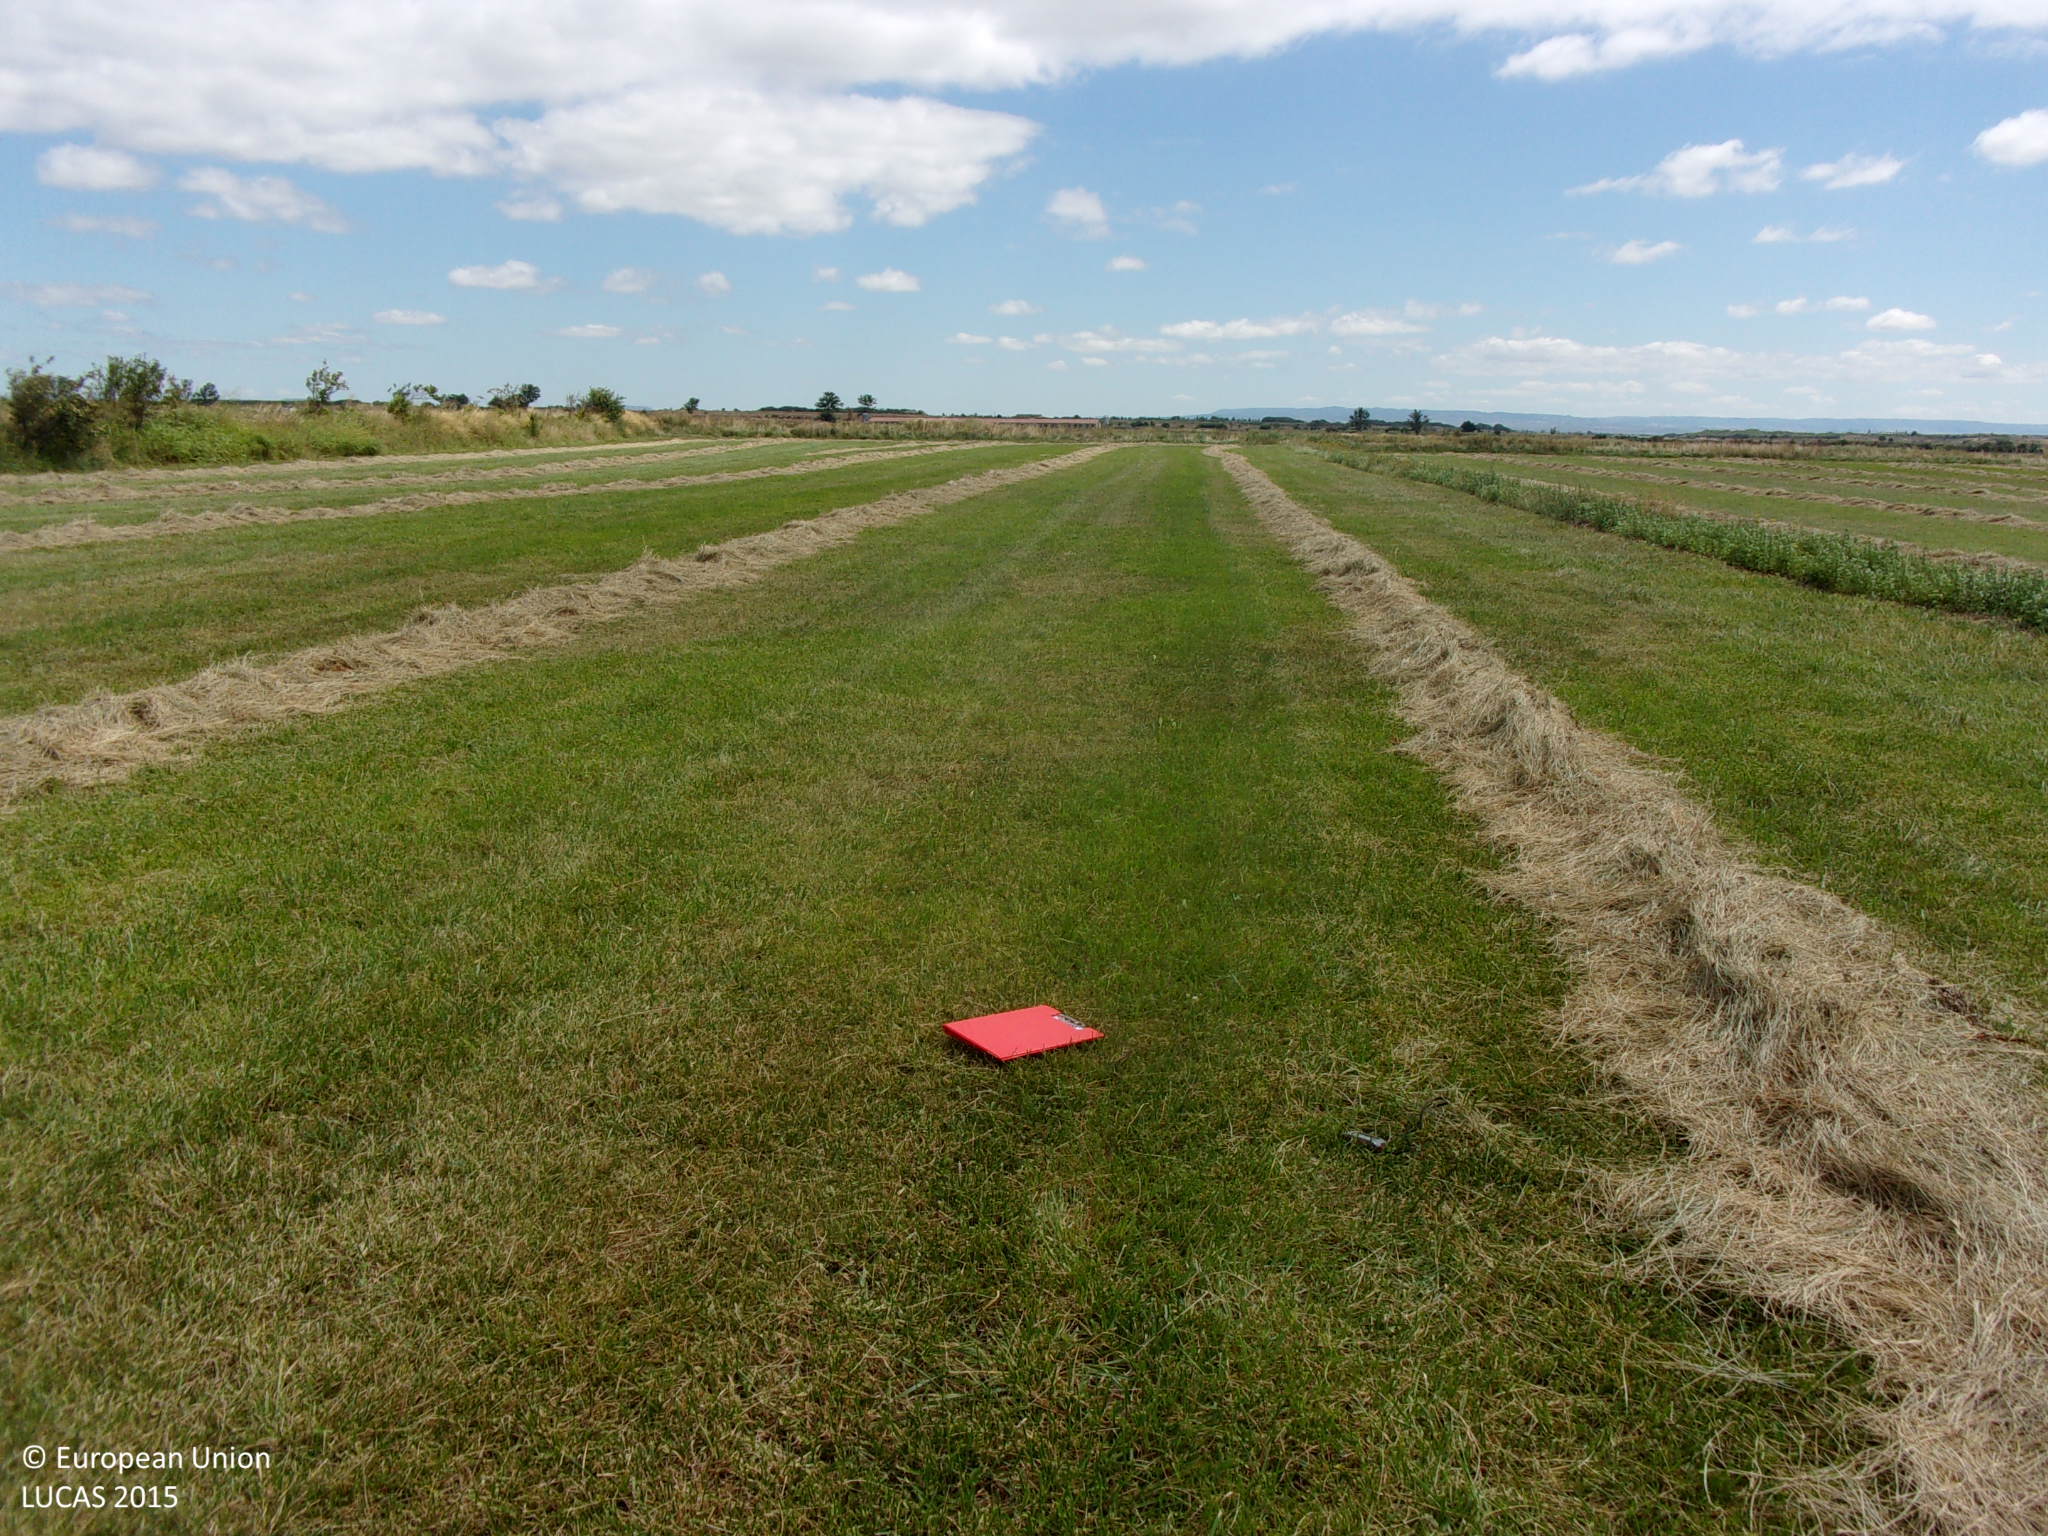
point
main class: Cropland
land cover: Mixed cereals for fodder
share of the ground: > 75 %
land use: Agriculture (excluding fallow land and kitchen gardens)
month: August
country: ES
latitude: 42.1600
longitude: -1.3468
